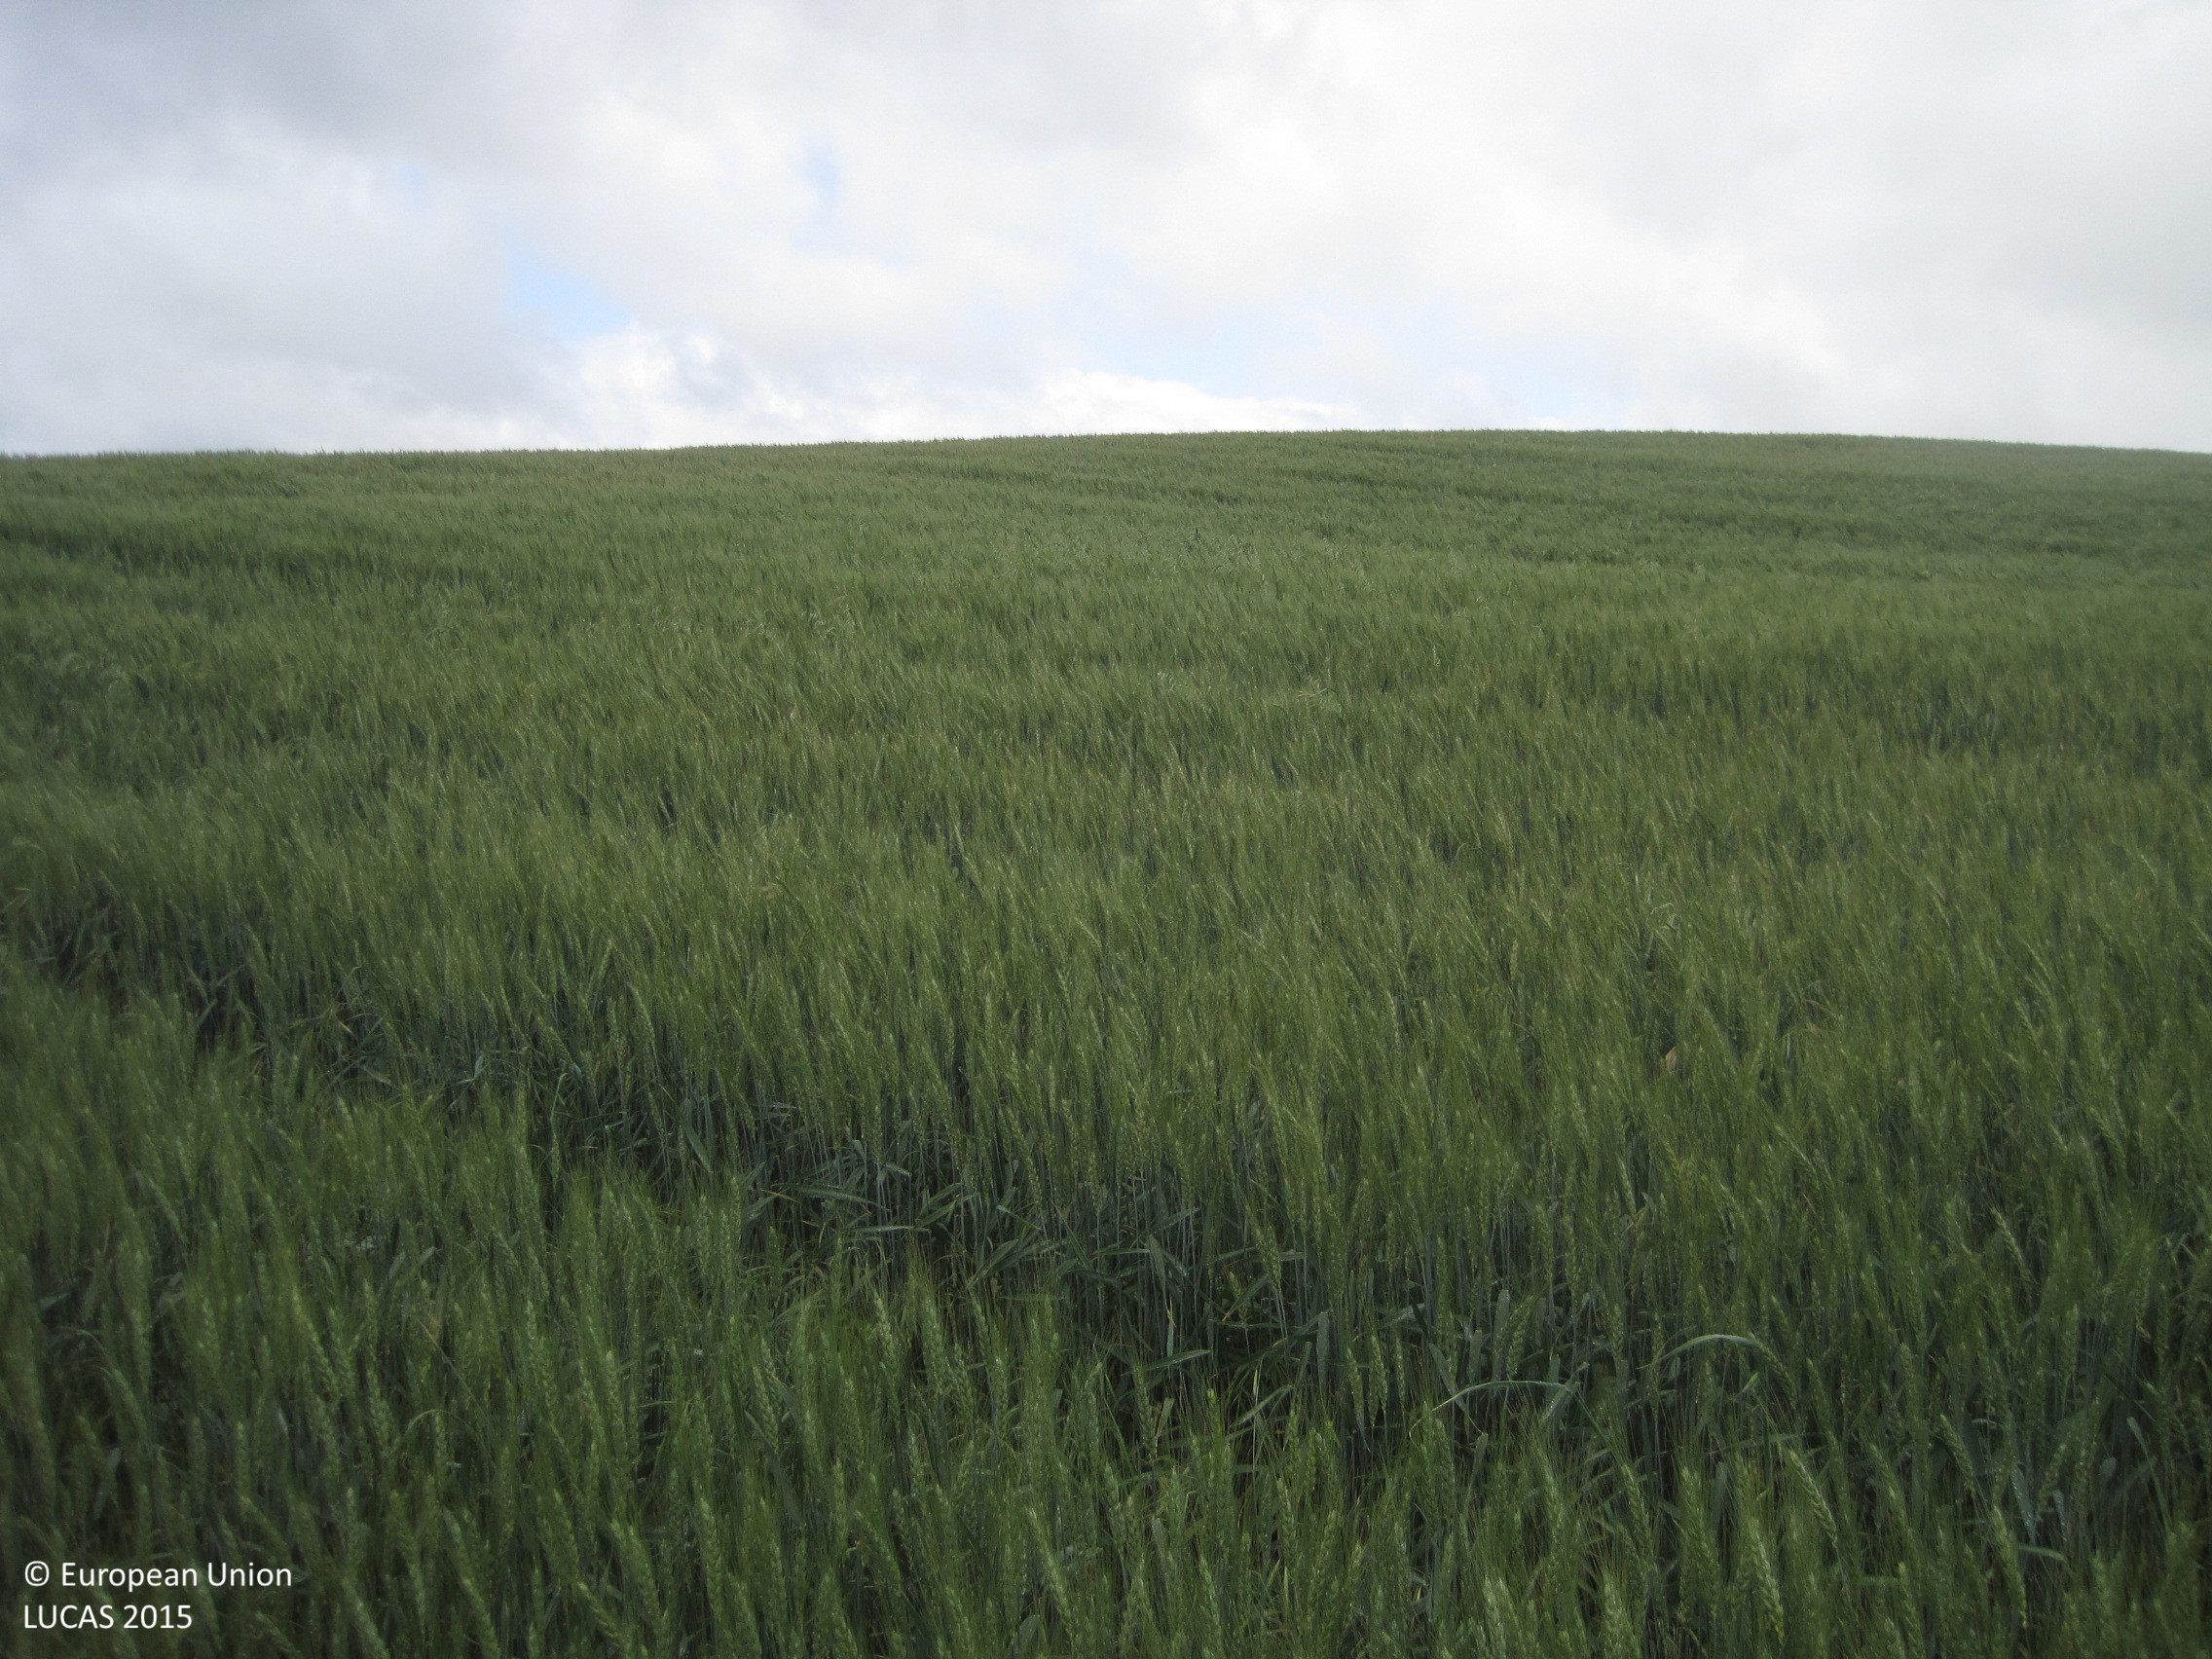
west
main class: Cropland
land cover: Durum wheat
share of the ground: > 75 %
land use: Agriculture (excluding fallow land and kitchen gardens)
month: May
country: ES
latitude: 42.5740
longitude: -1.2290
